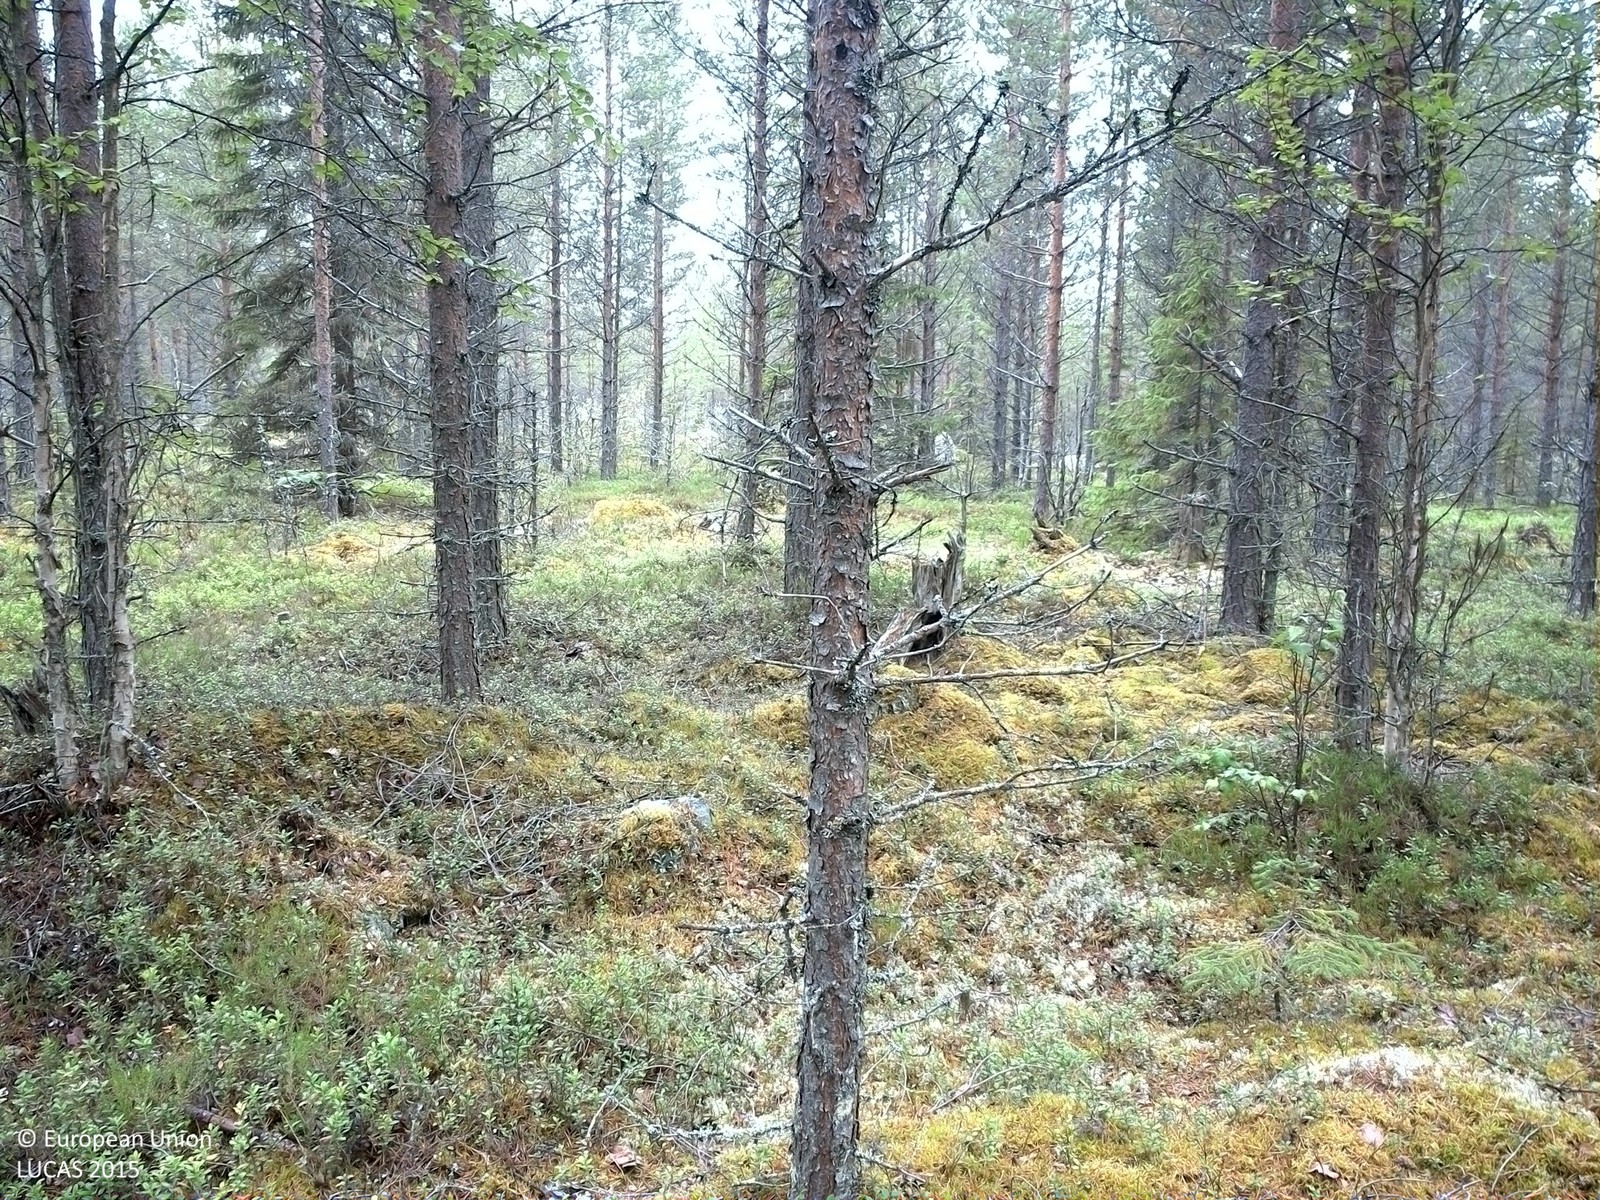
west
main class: Woodland
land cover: Pine dominated coniferous woodland
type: boreal forest
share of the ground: 50 - 75 %
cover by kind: coniferous forest trees 50 %, shrubs 30 %, lichens and mosses 15 %, broadleaved forest trees 5 %
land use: Forestry
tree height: > 5 m
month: July
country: SE
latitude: 63.6050
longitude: 17.0902
